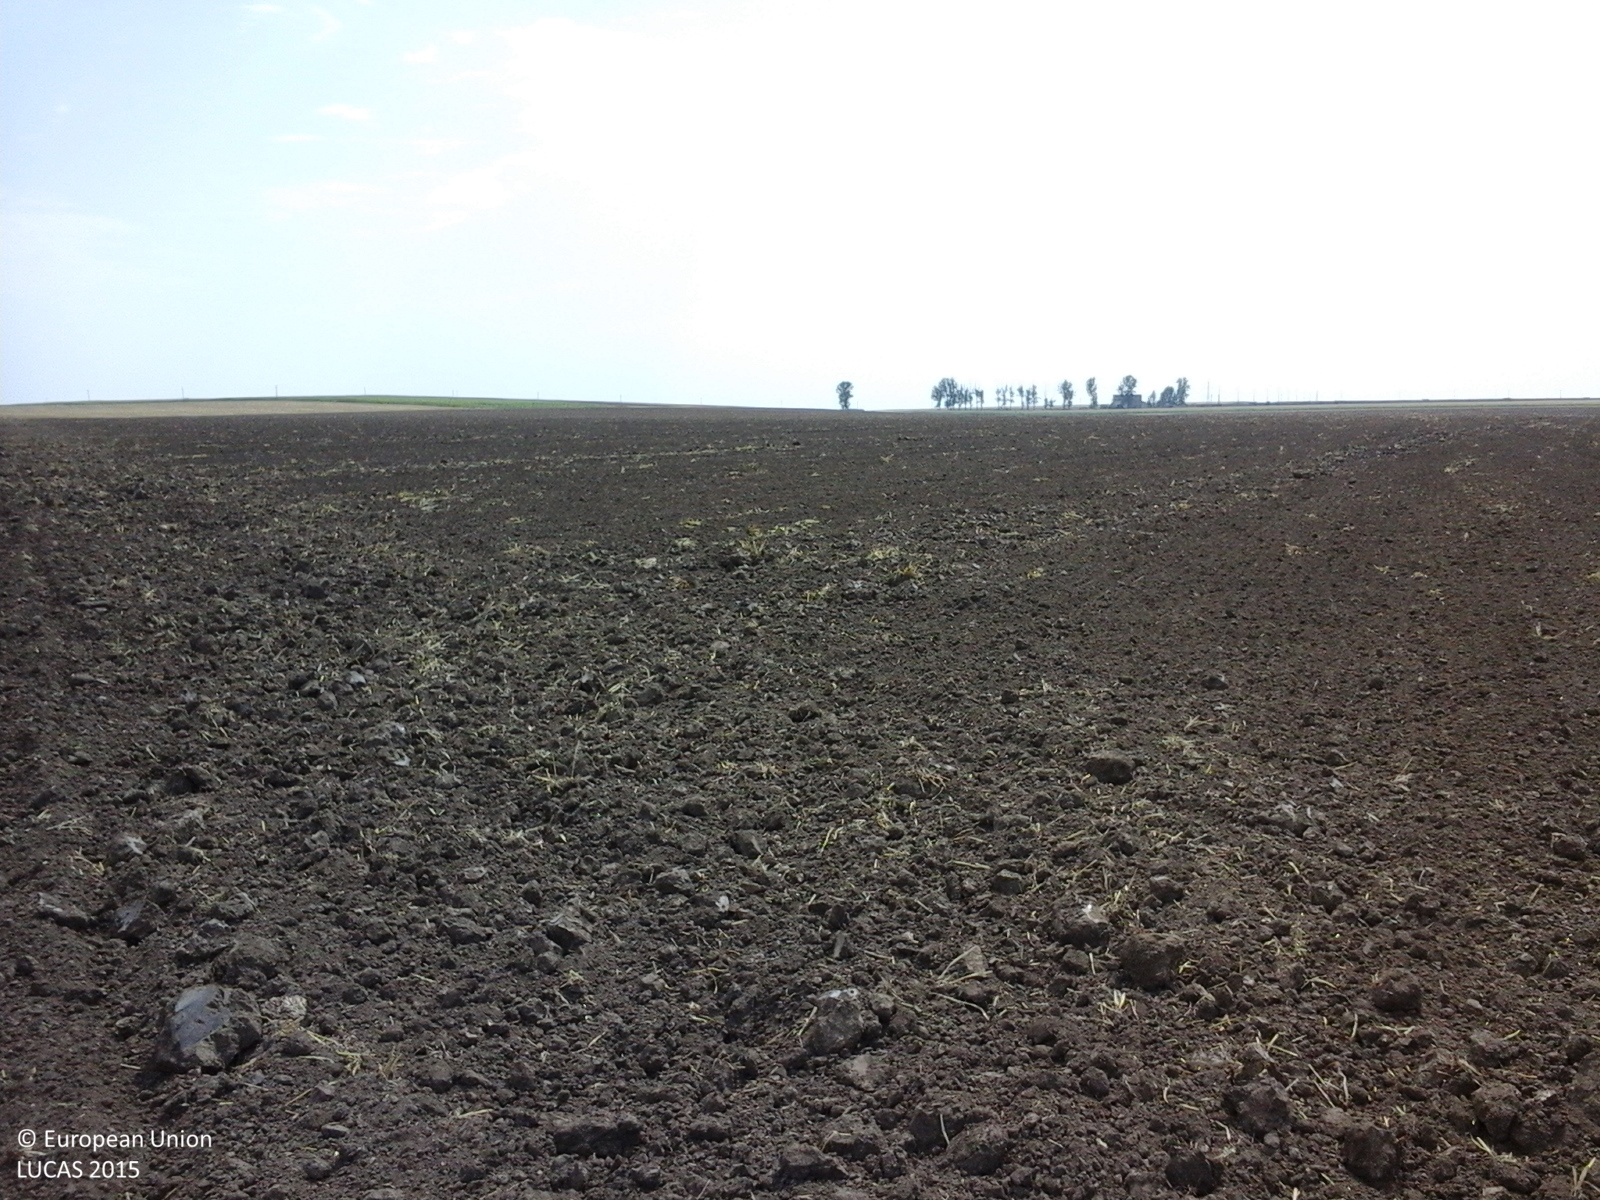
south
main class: Cropland
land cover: Common wheat
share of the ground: < 10 %
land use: Agriculture (excluding fallow land and kitchen gardens)
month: August
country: RO
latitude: 43.9229
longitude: 28.4099
